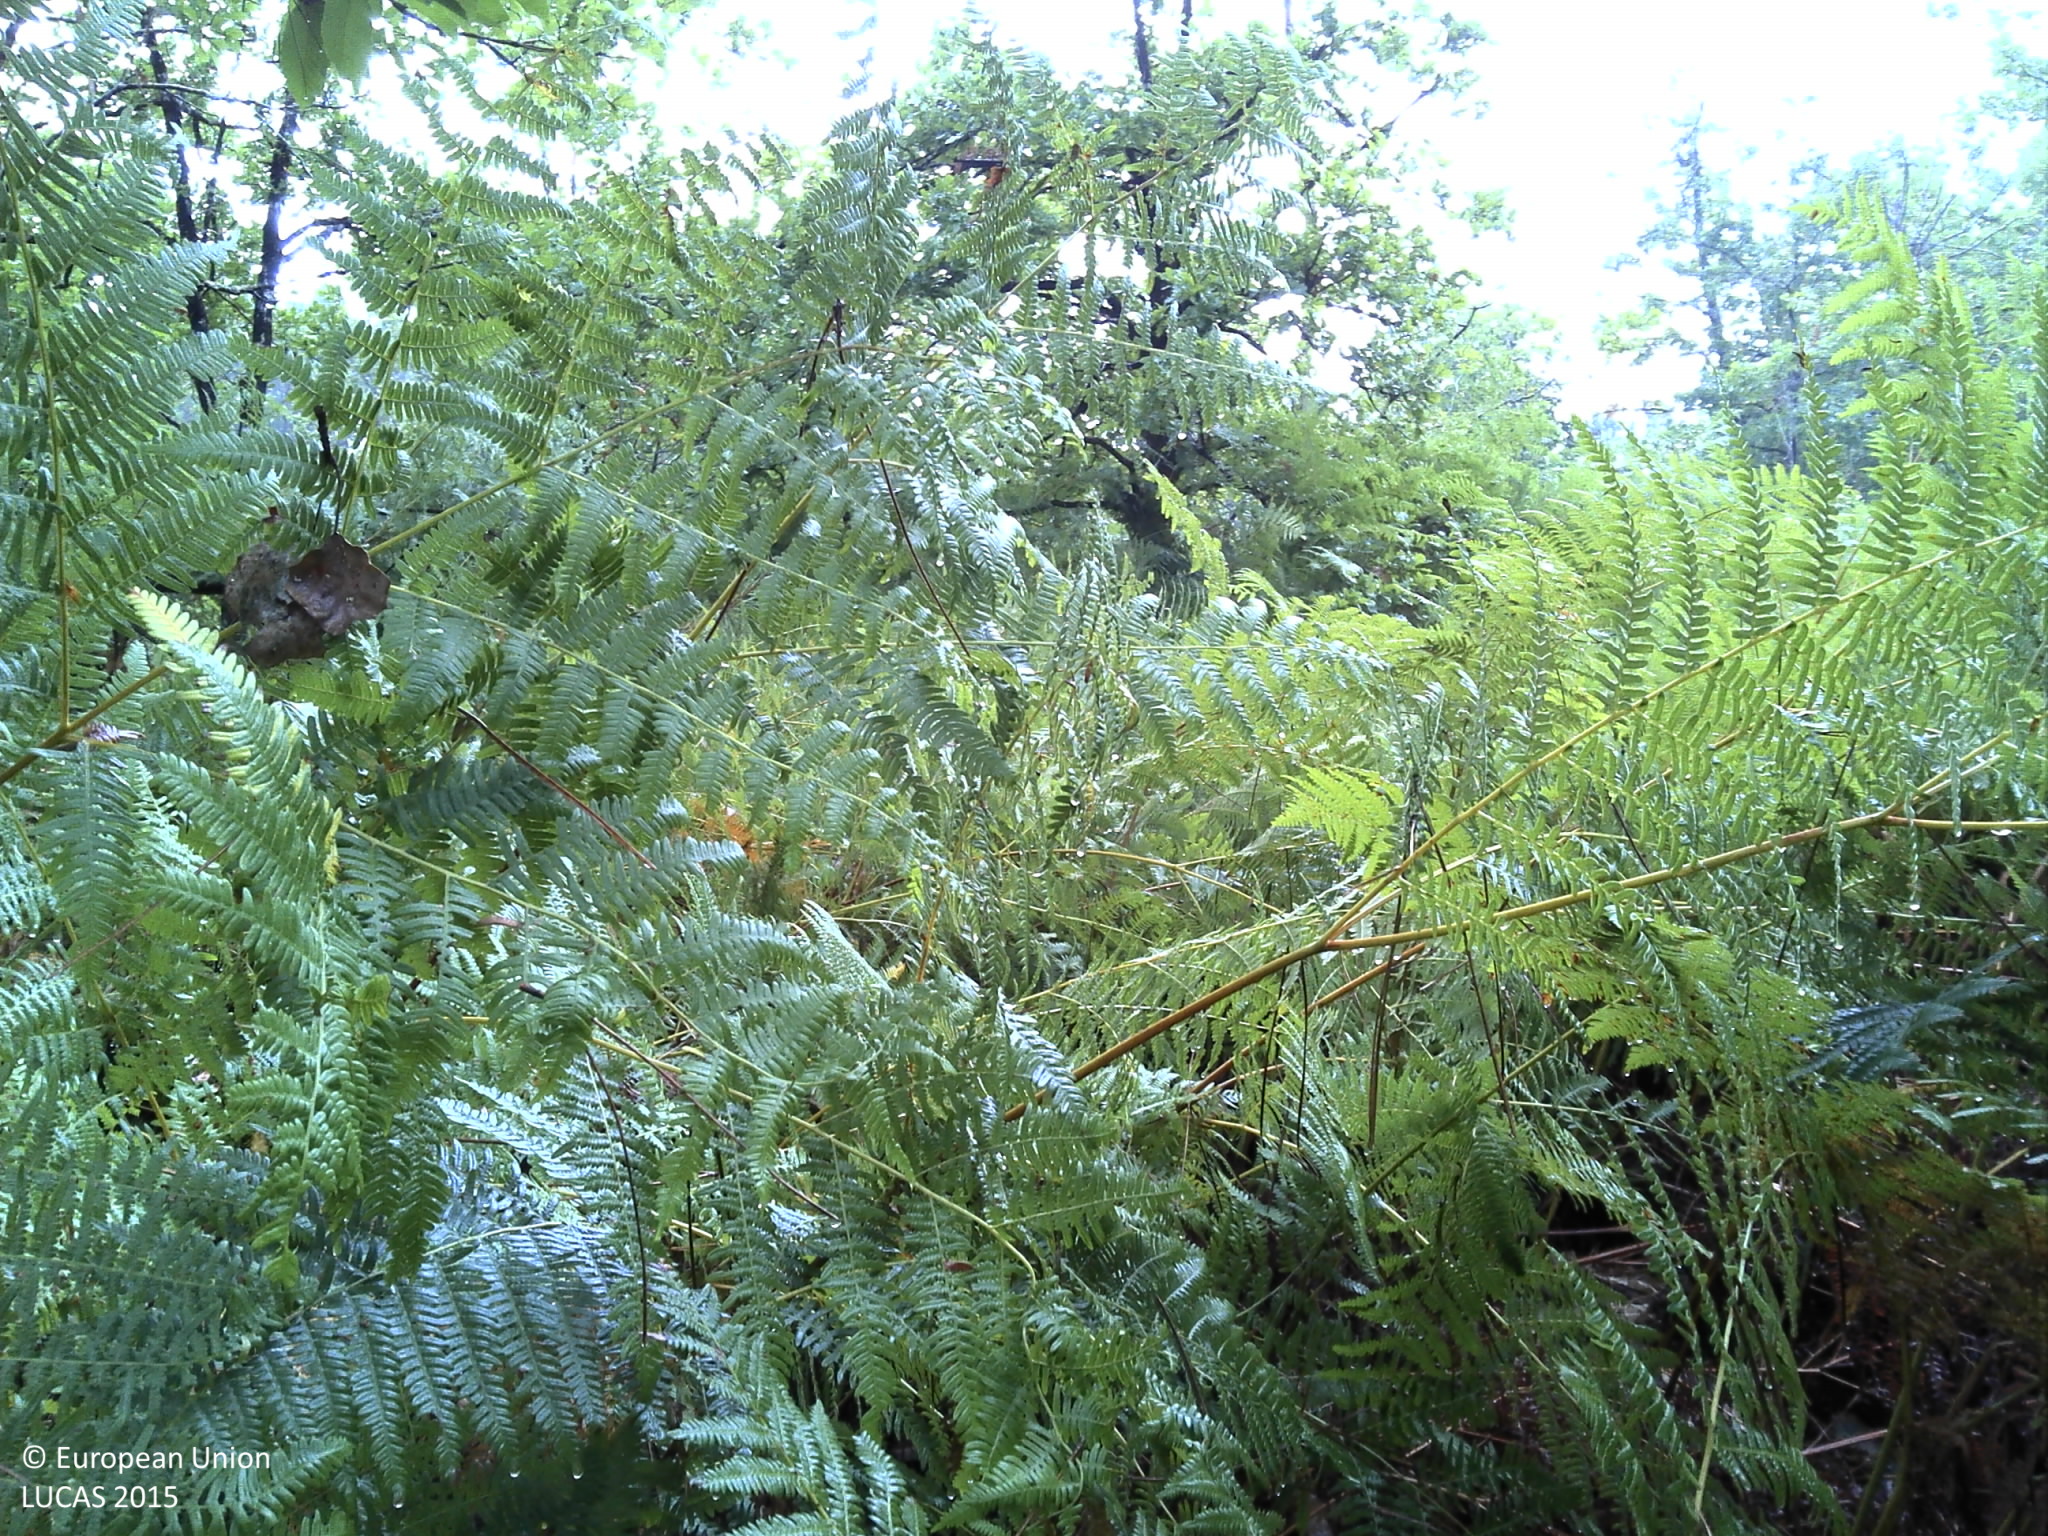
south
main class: Woodland
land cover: Pine dominated mixed woodland
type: coniferous forest of the mediterranean region
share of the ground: > 75 %
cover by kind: broadleaved forest trees 40 %, shrubs 30 %, coniferous forest trees 20 %, herbaceous plants 10 %
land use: Forestry
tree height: > 5 m
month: August
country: FR
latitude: 45.2105
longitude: -0.5503
